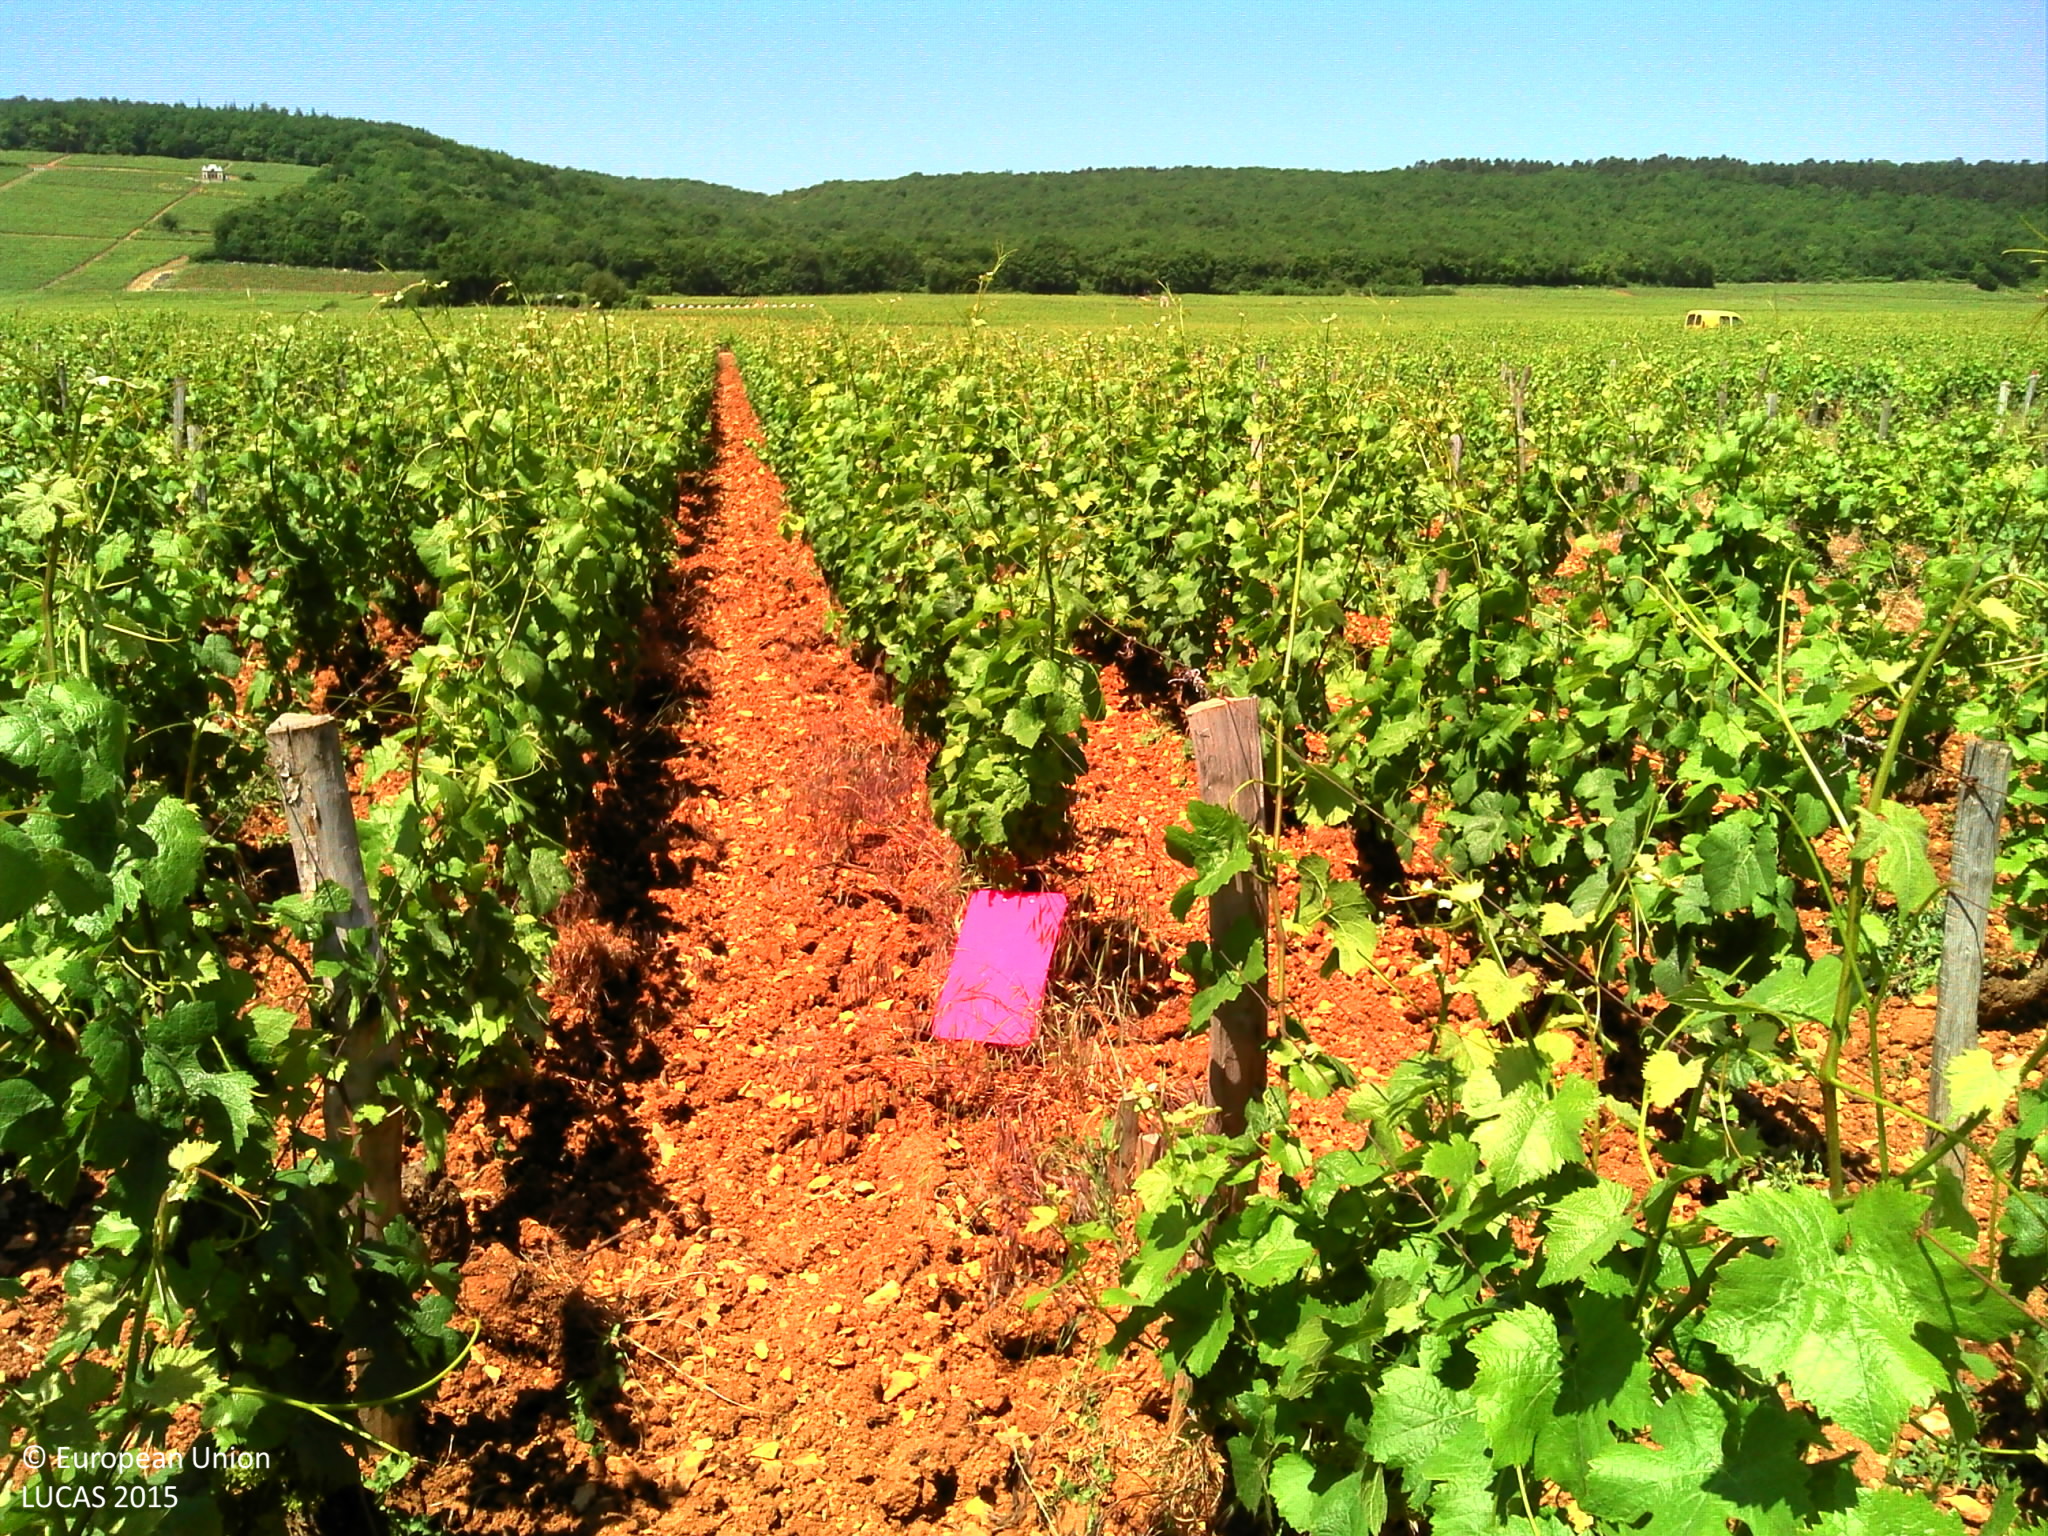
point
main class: Cropland
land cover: Vineyards
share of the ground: 50 - 75 %
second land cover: Other bare soil
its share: > 75 %
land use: Agriculture (excluding fallow land and kitchen gardens)
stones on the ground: > 50 %
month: June
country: FR
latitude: 47.2071
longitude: 4.9706
